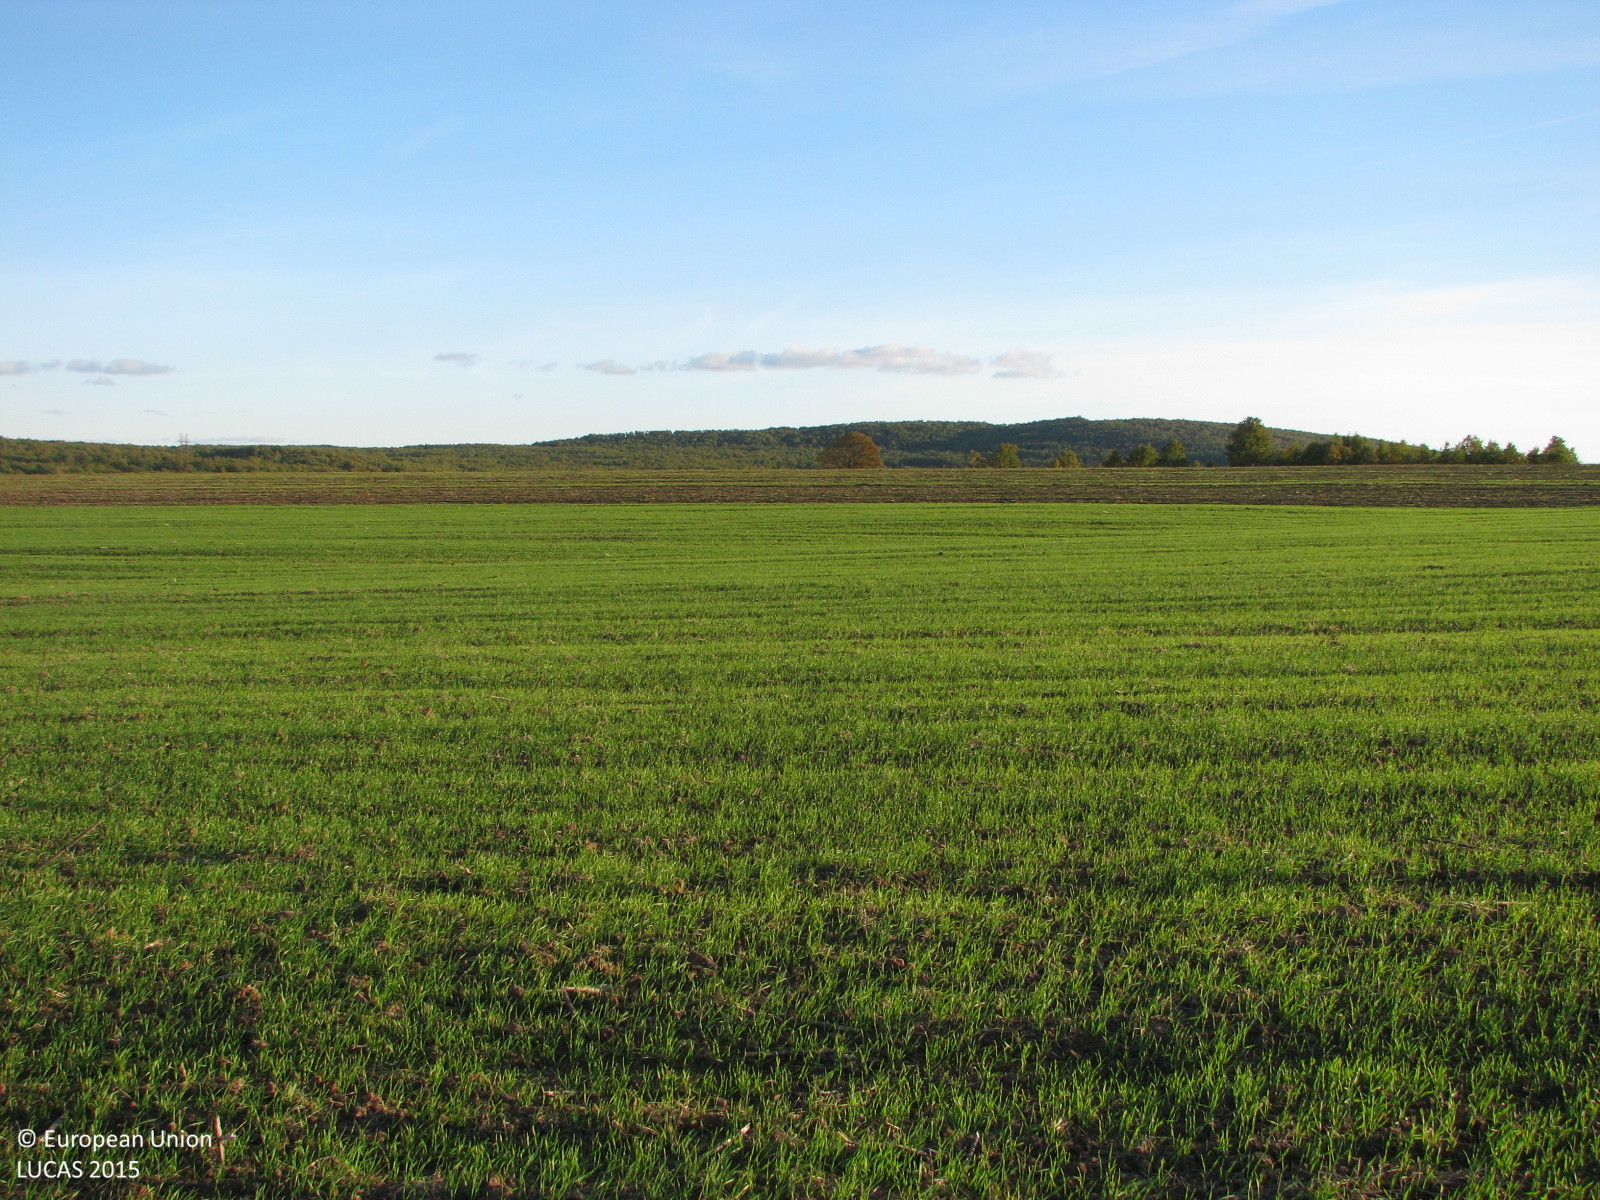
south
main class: Cropland
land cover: Common wheat
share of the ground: > 75 %
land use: Agriculture (excluding fallow land and kitchen gardens)
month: October
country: BG
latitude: 42.2847
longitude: 26.8204
